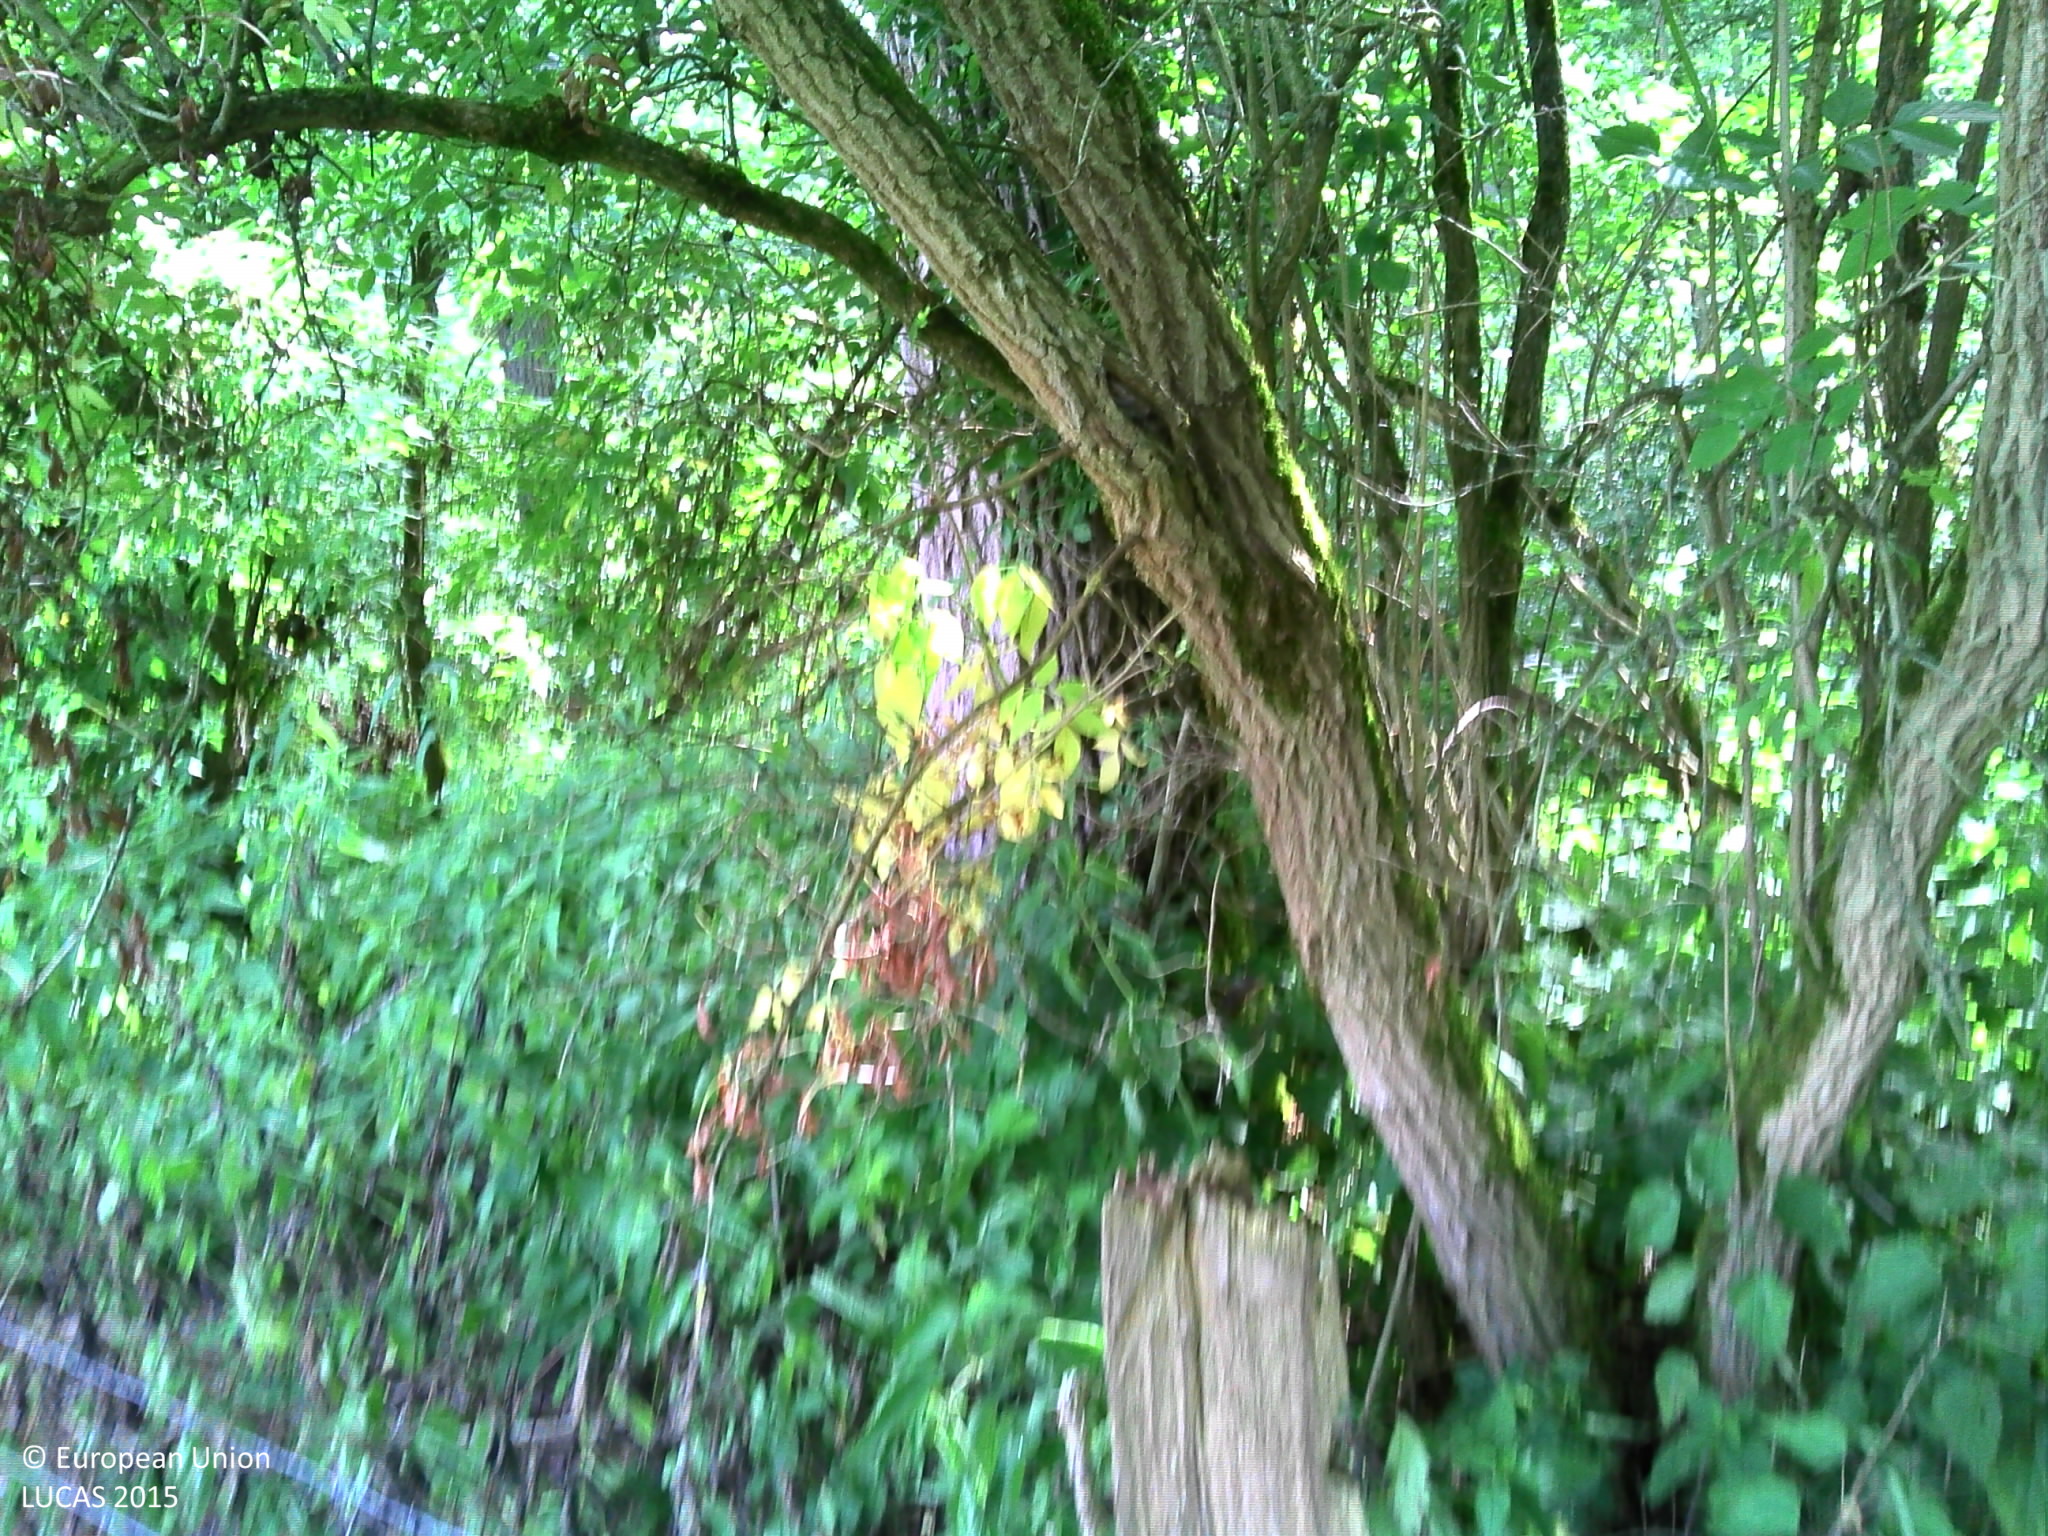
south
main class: Woodland
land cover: Spruce dominated mixed woodland
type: acidophilous oak and oak-birch forest
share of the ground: > 75 %
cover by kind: coniferous forest trees 50 %, herbaceous plants 25 %, broadleaved forest trees 20 %, shrubs 5 %
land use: Forestry
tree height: > 5 m
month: June
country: BE
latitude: 50.5144
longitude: 3.6892
